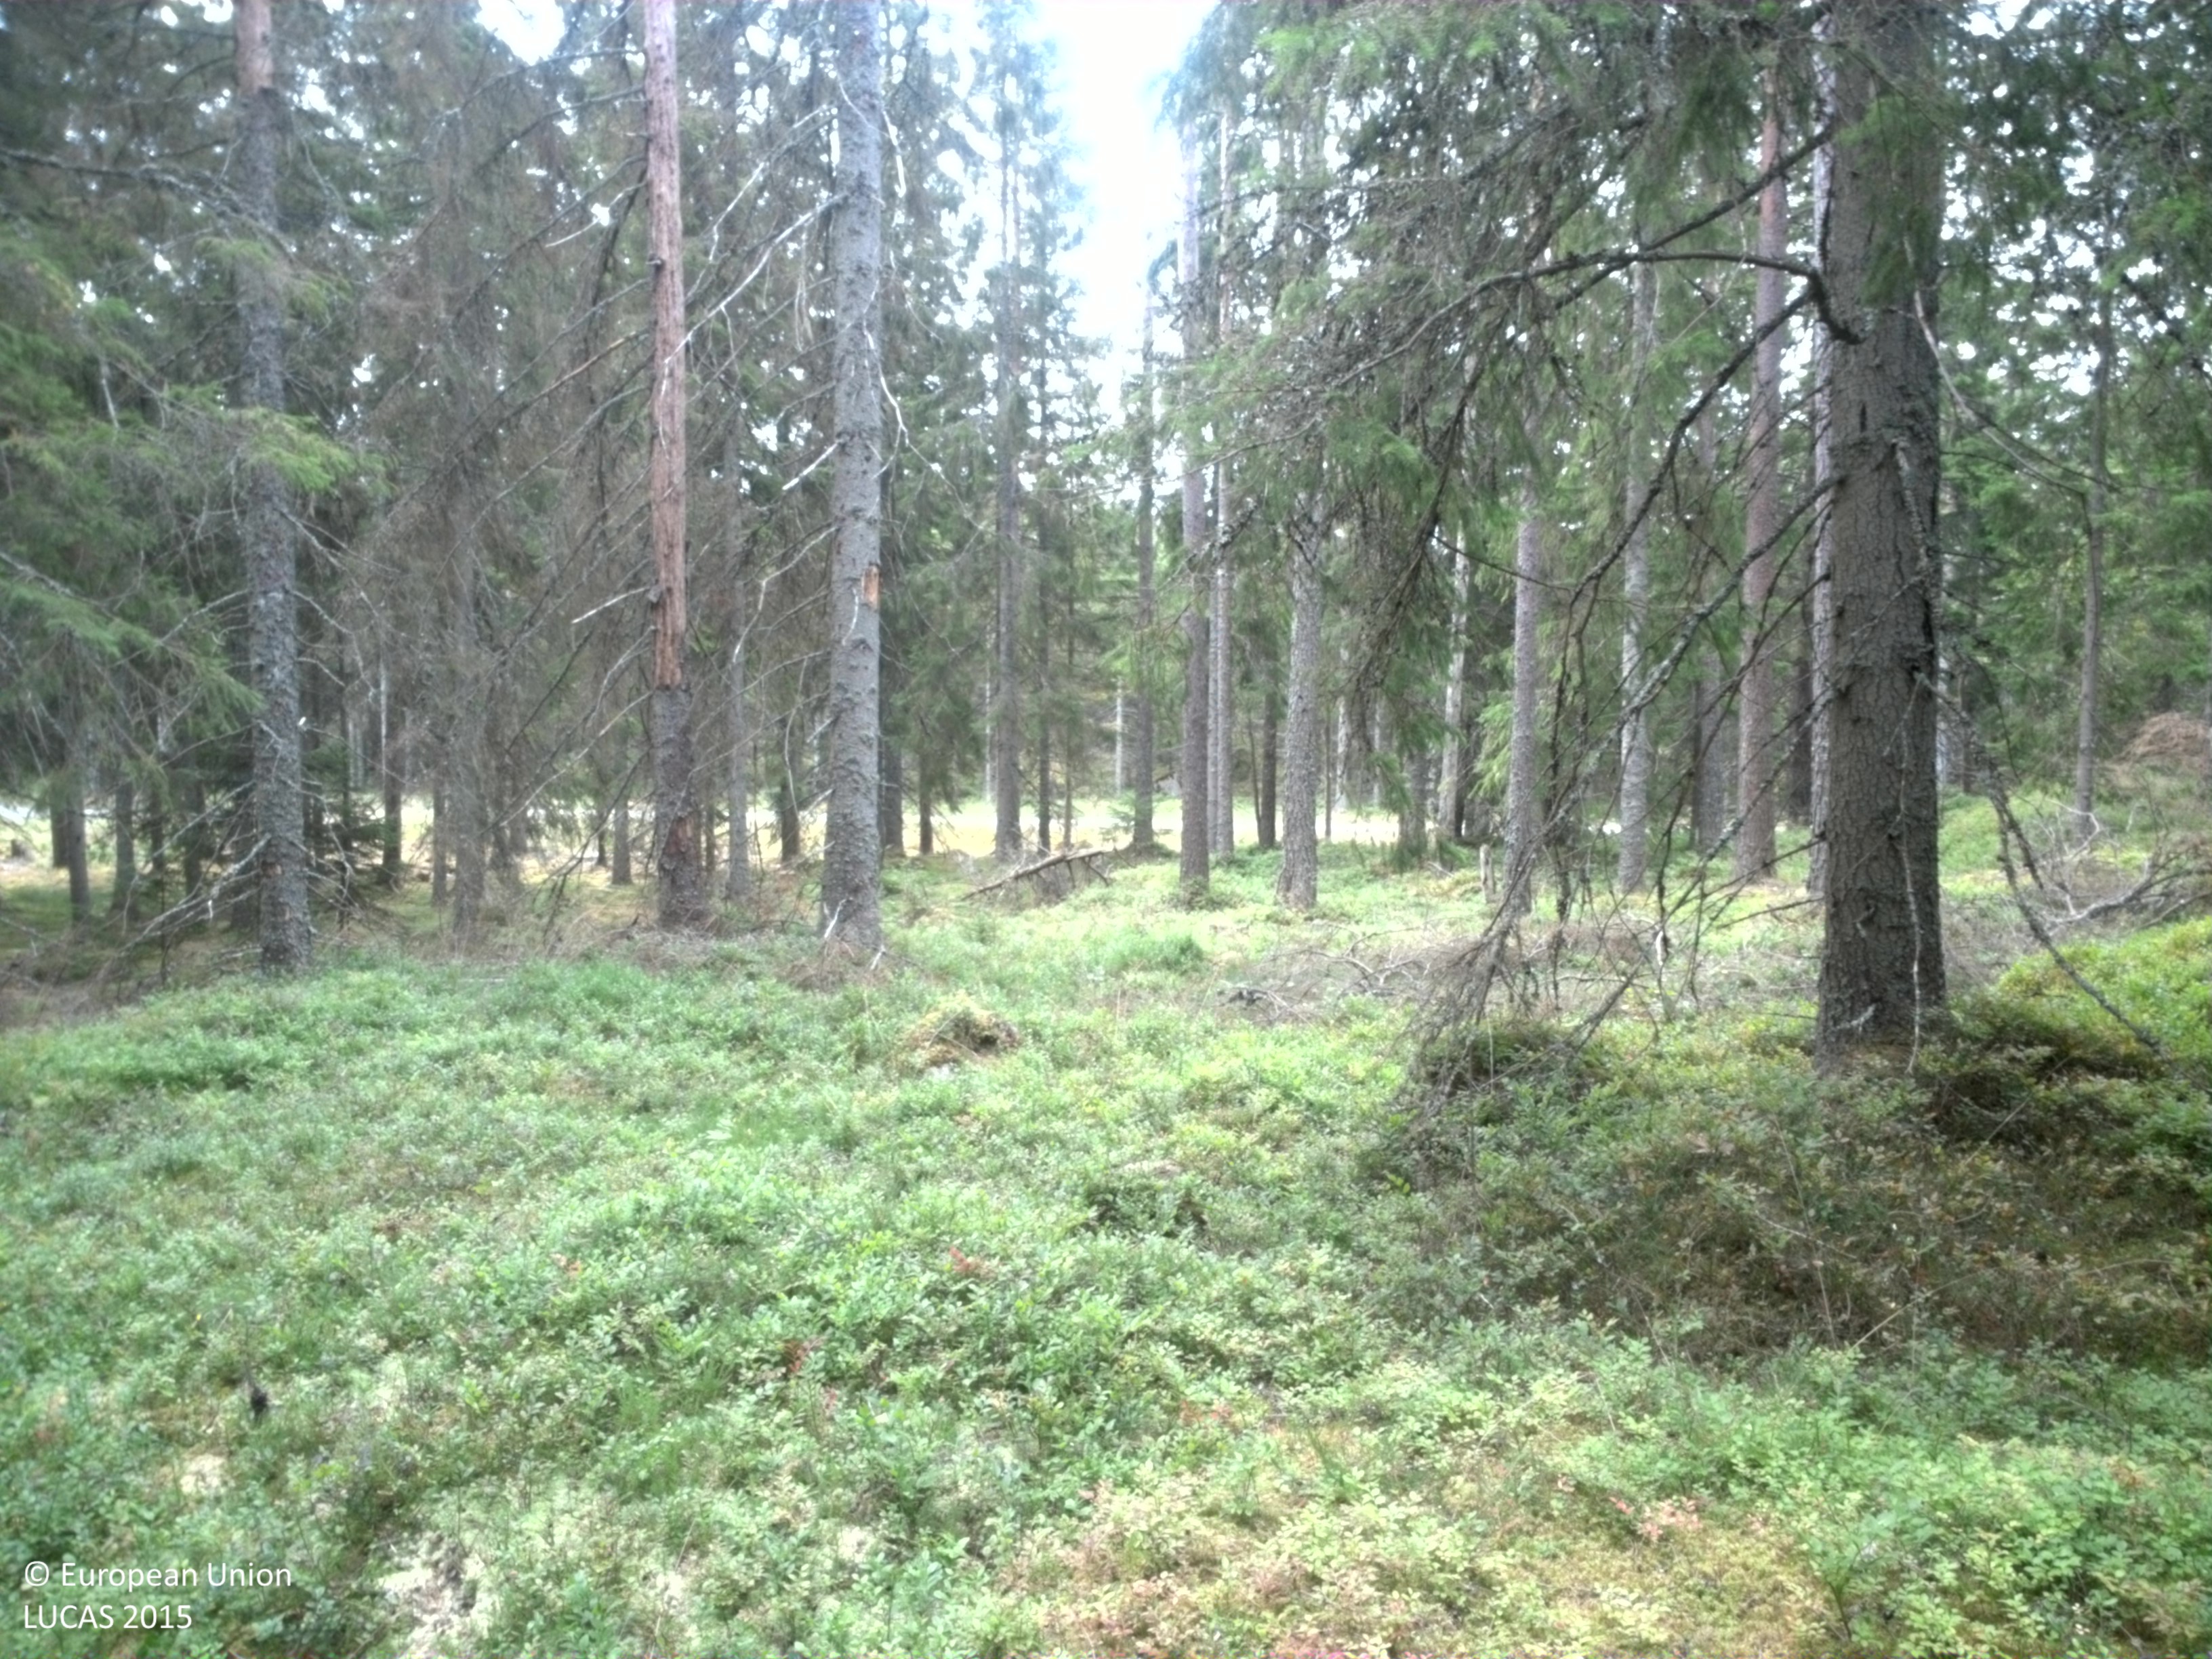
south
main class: Woodland
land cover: Spruce dominated coniferous woodland
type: boreal forest
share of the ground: 50 - 75 %
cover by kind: coniferous forest trees 55 %, shrubs 30 %, lichens and mosses 15 %
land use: Forestry
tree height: > 5 m
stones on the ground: 10 - 25 %
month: August
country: SE
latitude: 57.9829
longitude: 13.9011
